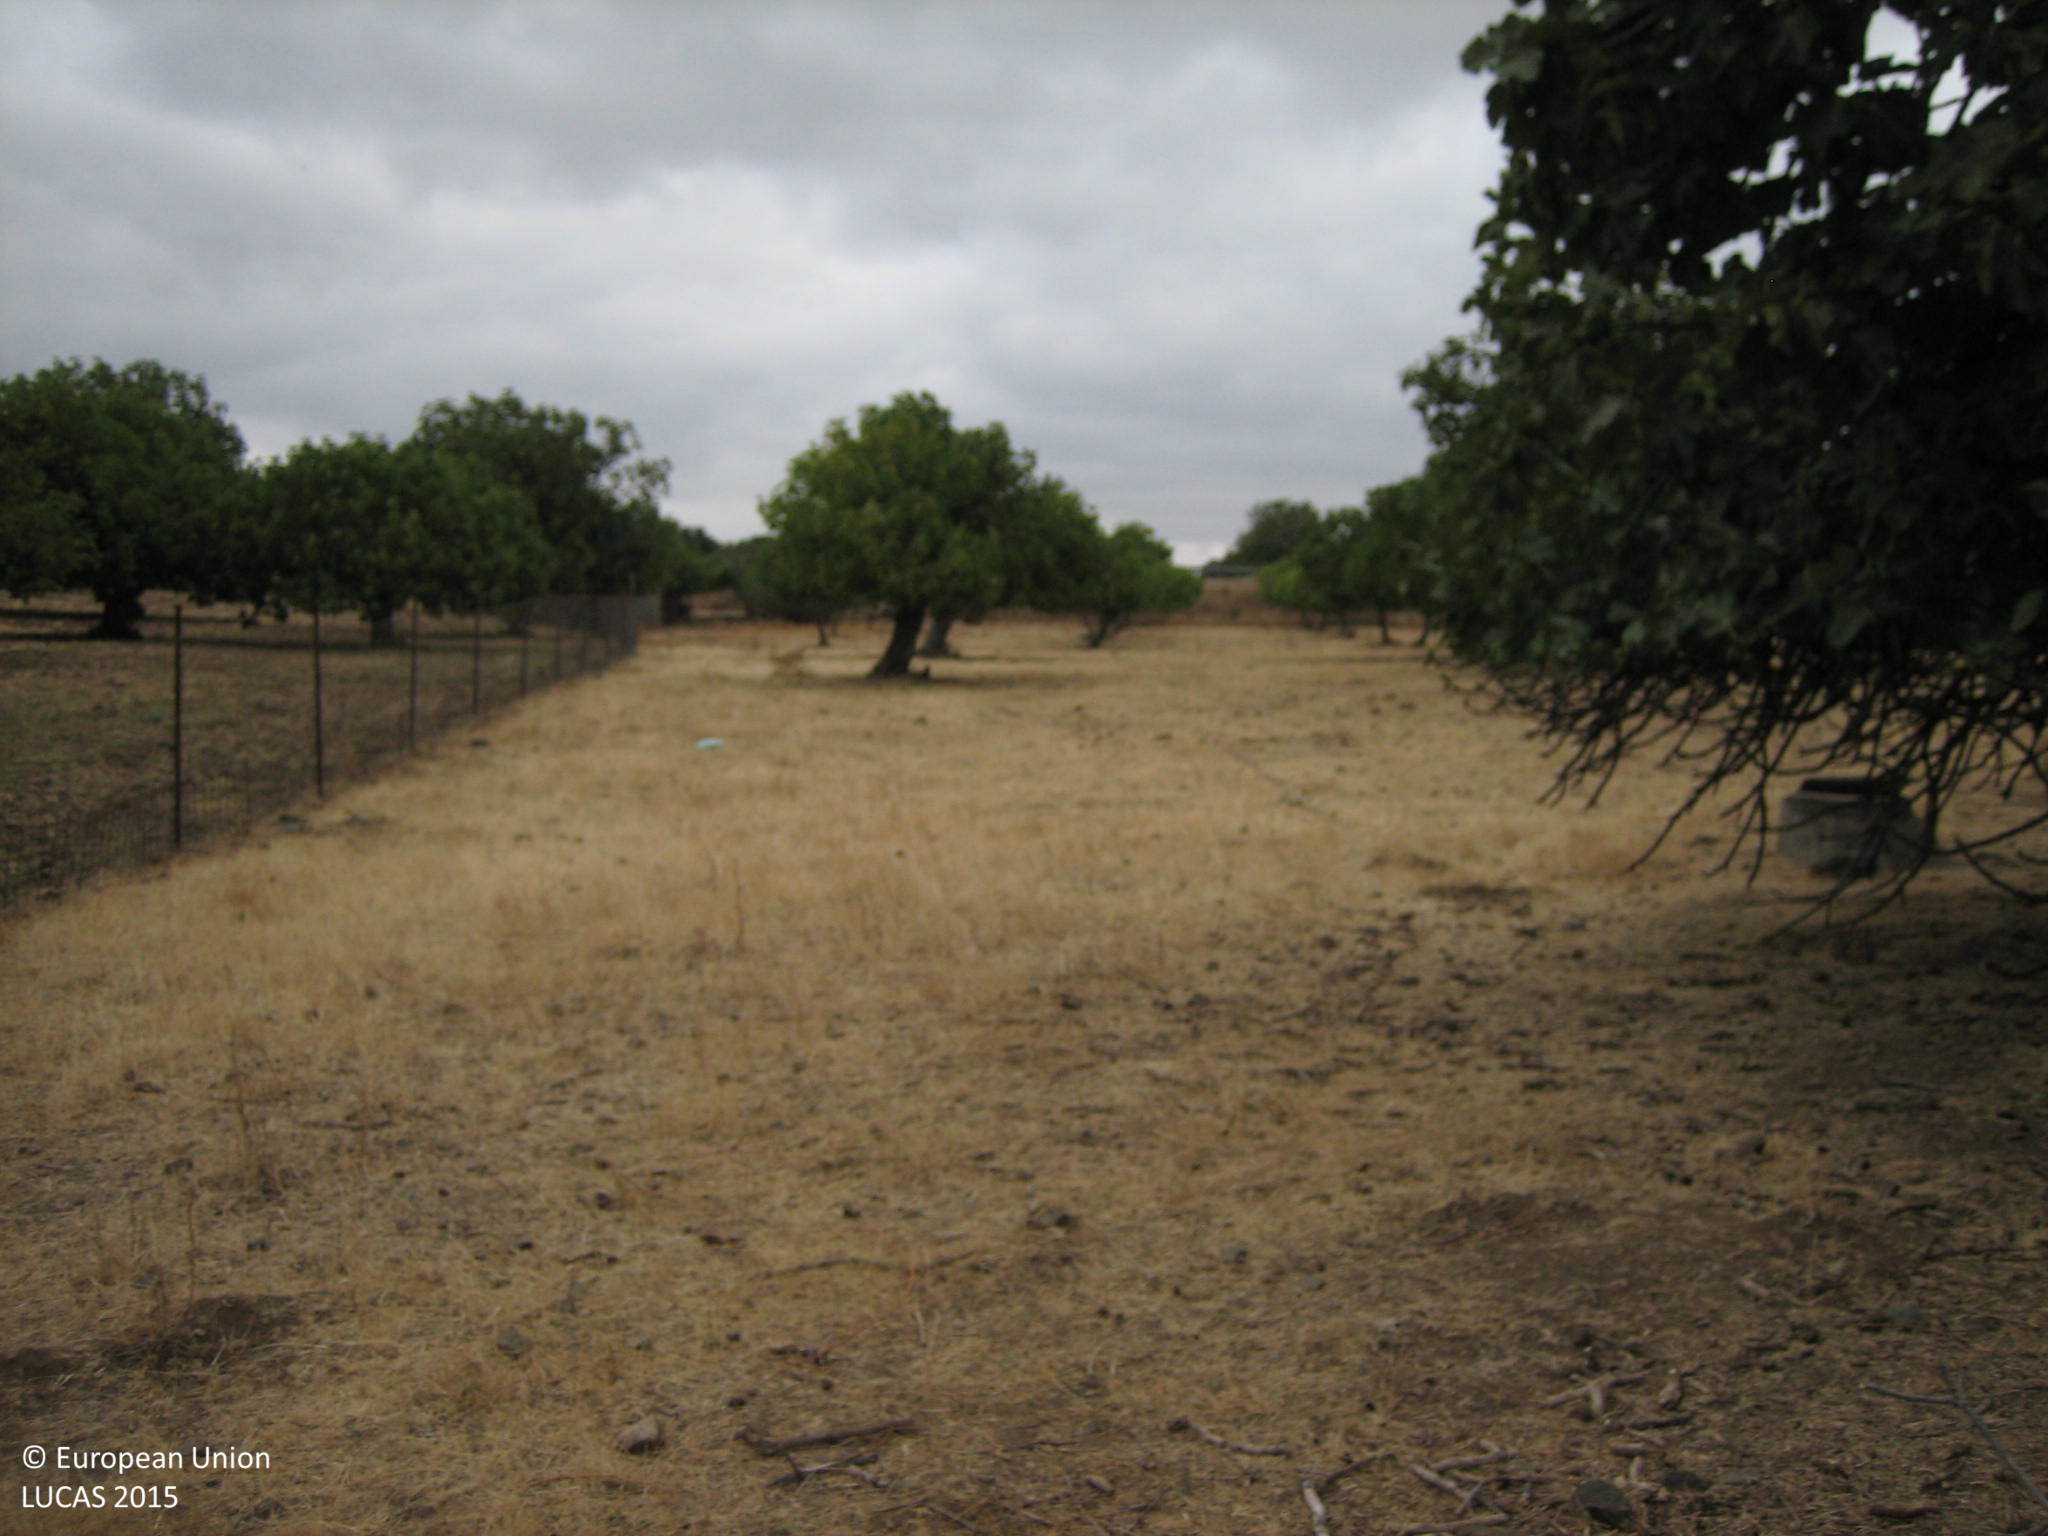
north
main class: Cropland
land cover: Other fruit trees and berries
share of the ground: 25 - 50 %
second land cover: Spontaneously vegetated surfaces
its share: 10 - 25 %
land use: Agriculture (excluding fallow land and kitchen gardens)
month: September
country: ES
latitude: 38.5190
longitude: -6.8636
